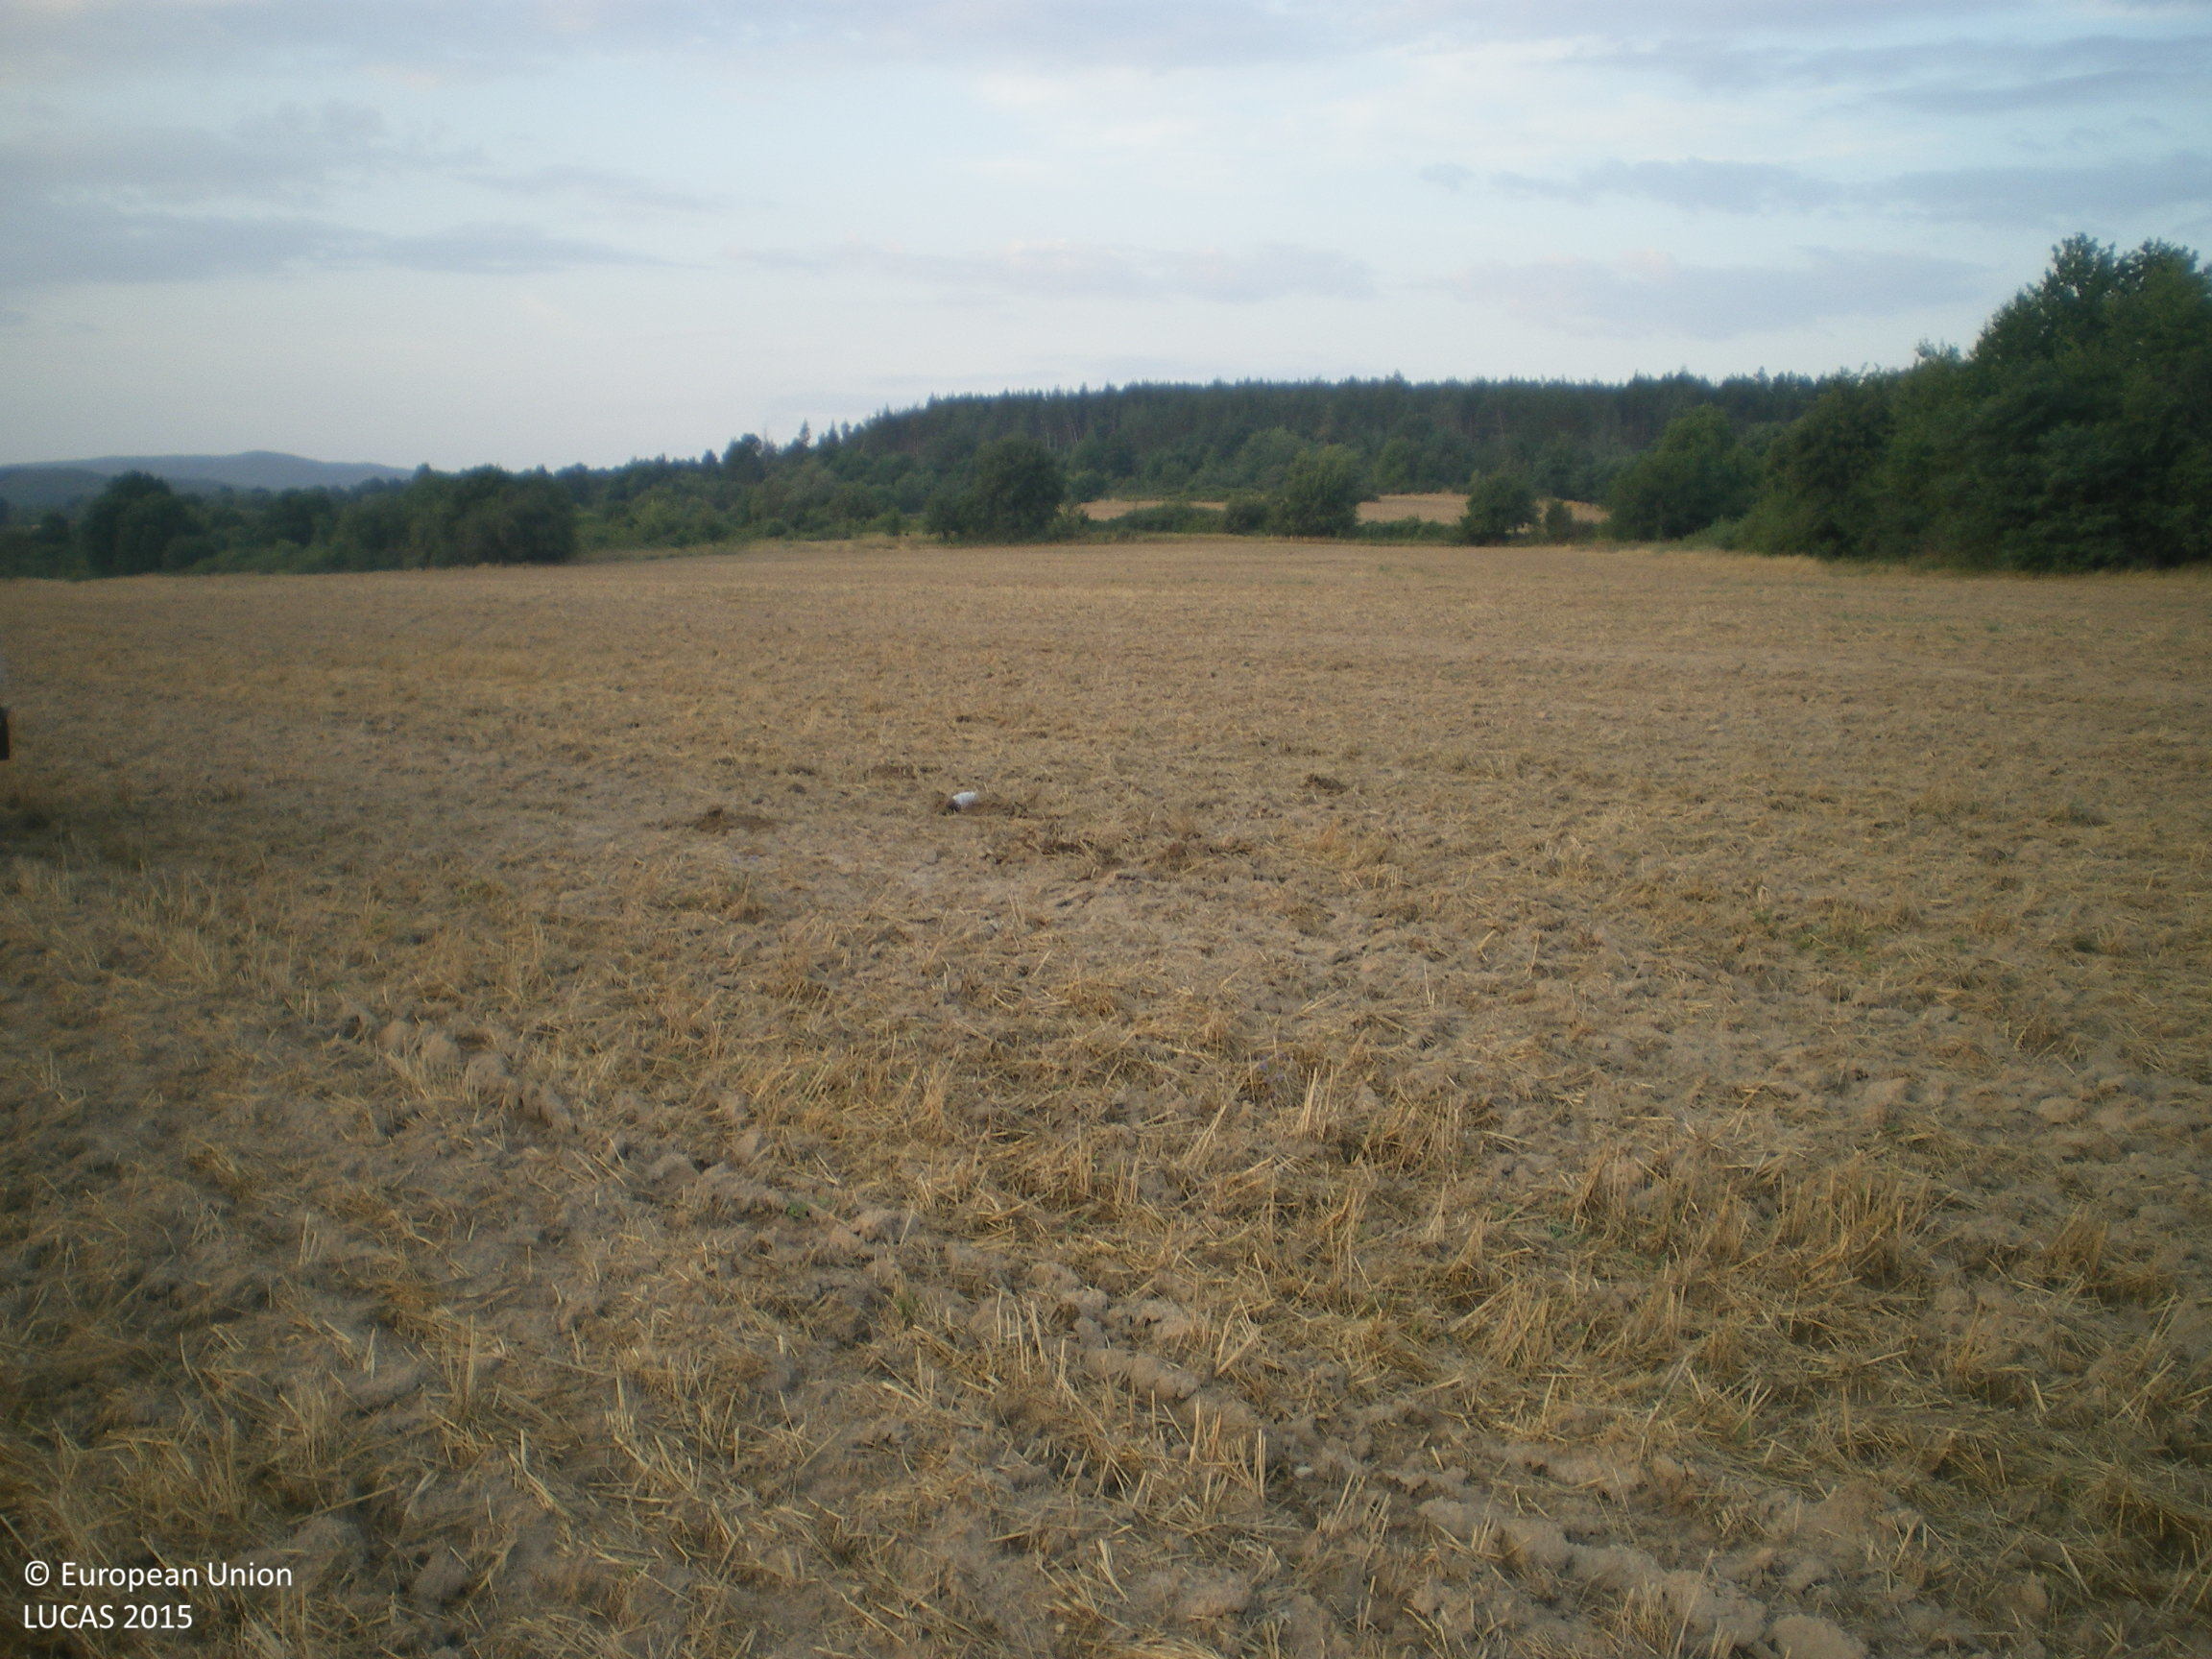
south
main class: Cropland
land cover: Common wheat
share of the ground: 10 - 25 %
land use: Agriculture (excluding fallow land and kitchen gardens)
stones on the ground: < 10 %
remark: Harvested field
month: August
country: BG
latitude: 42.5616
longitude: 25.3295
